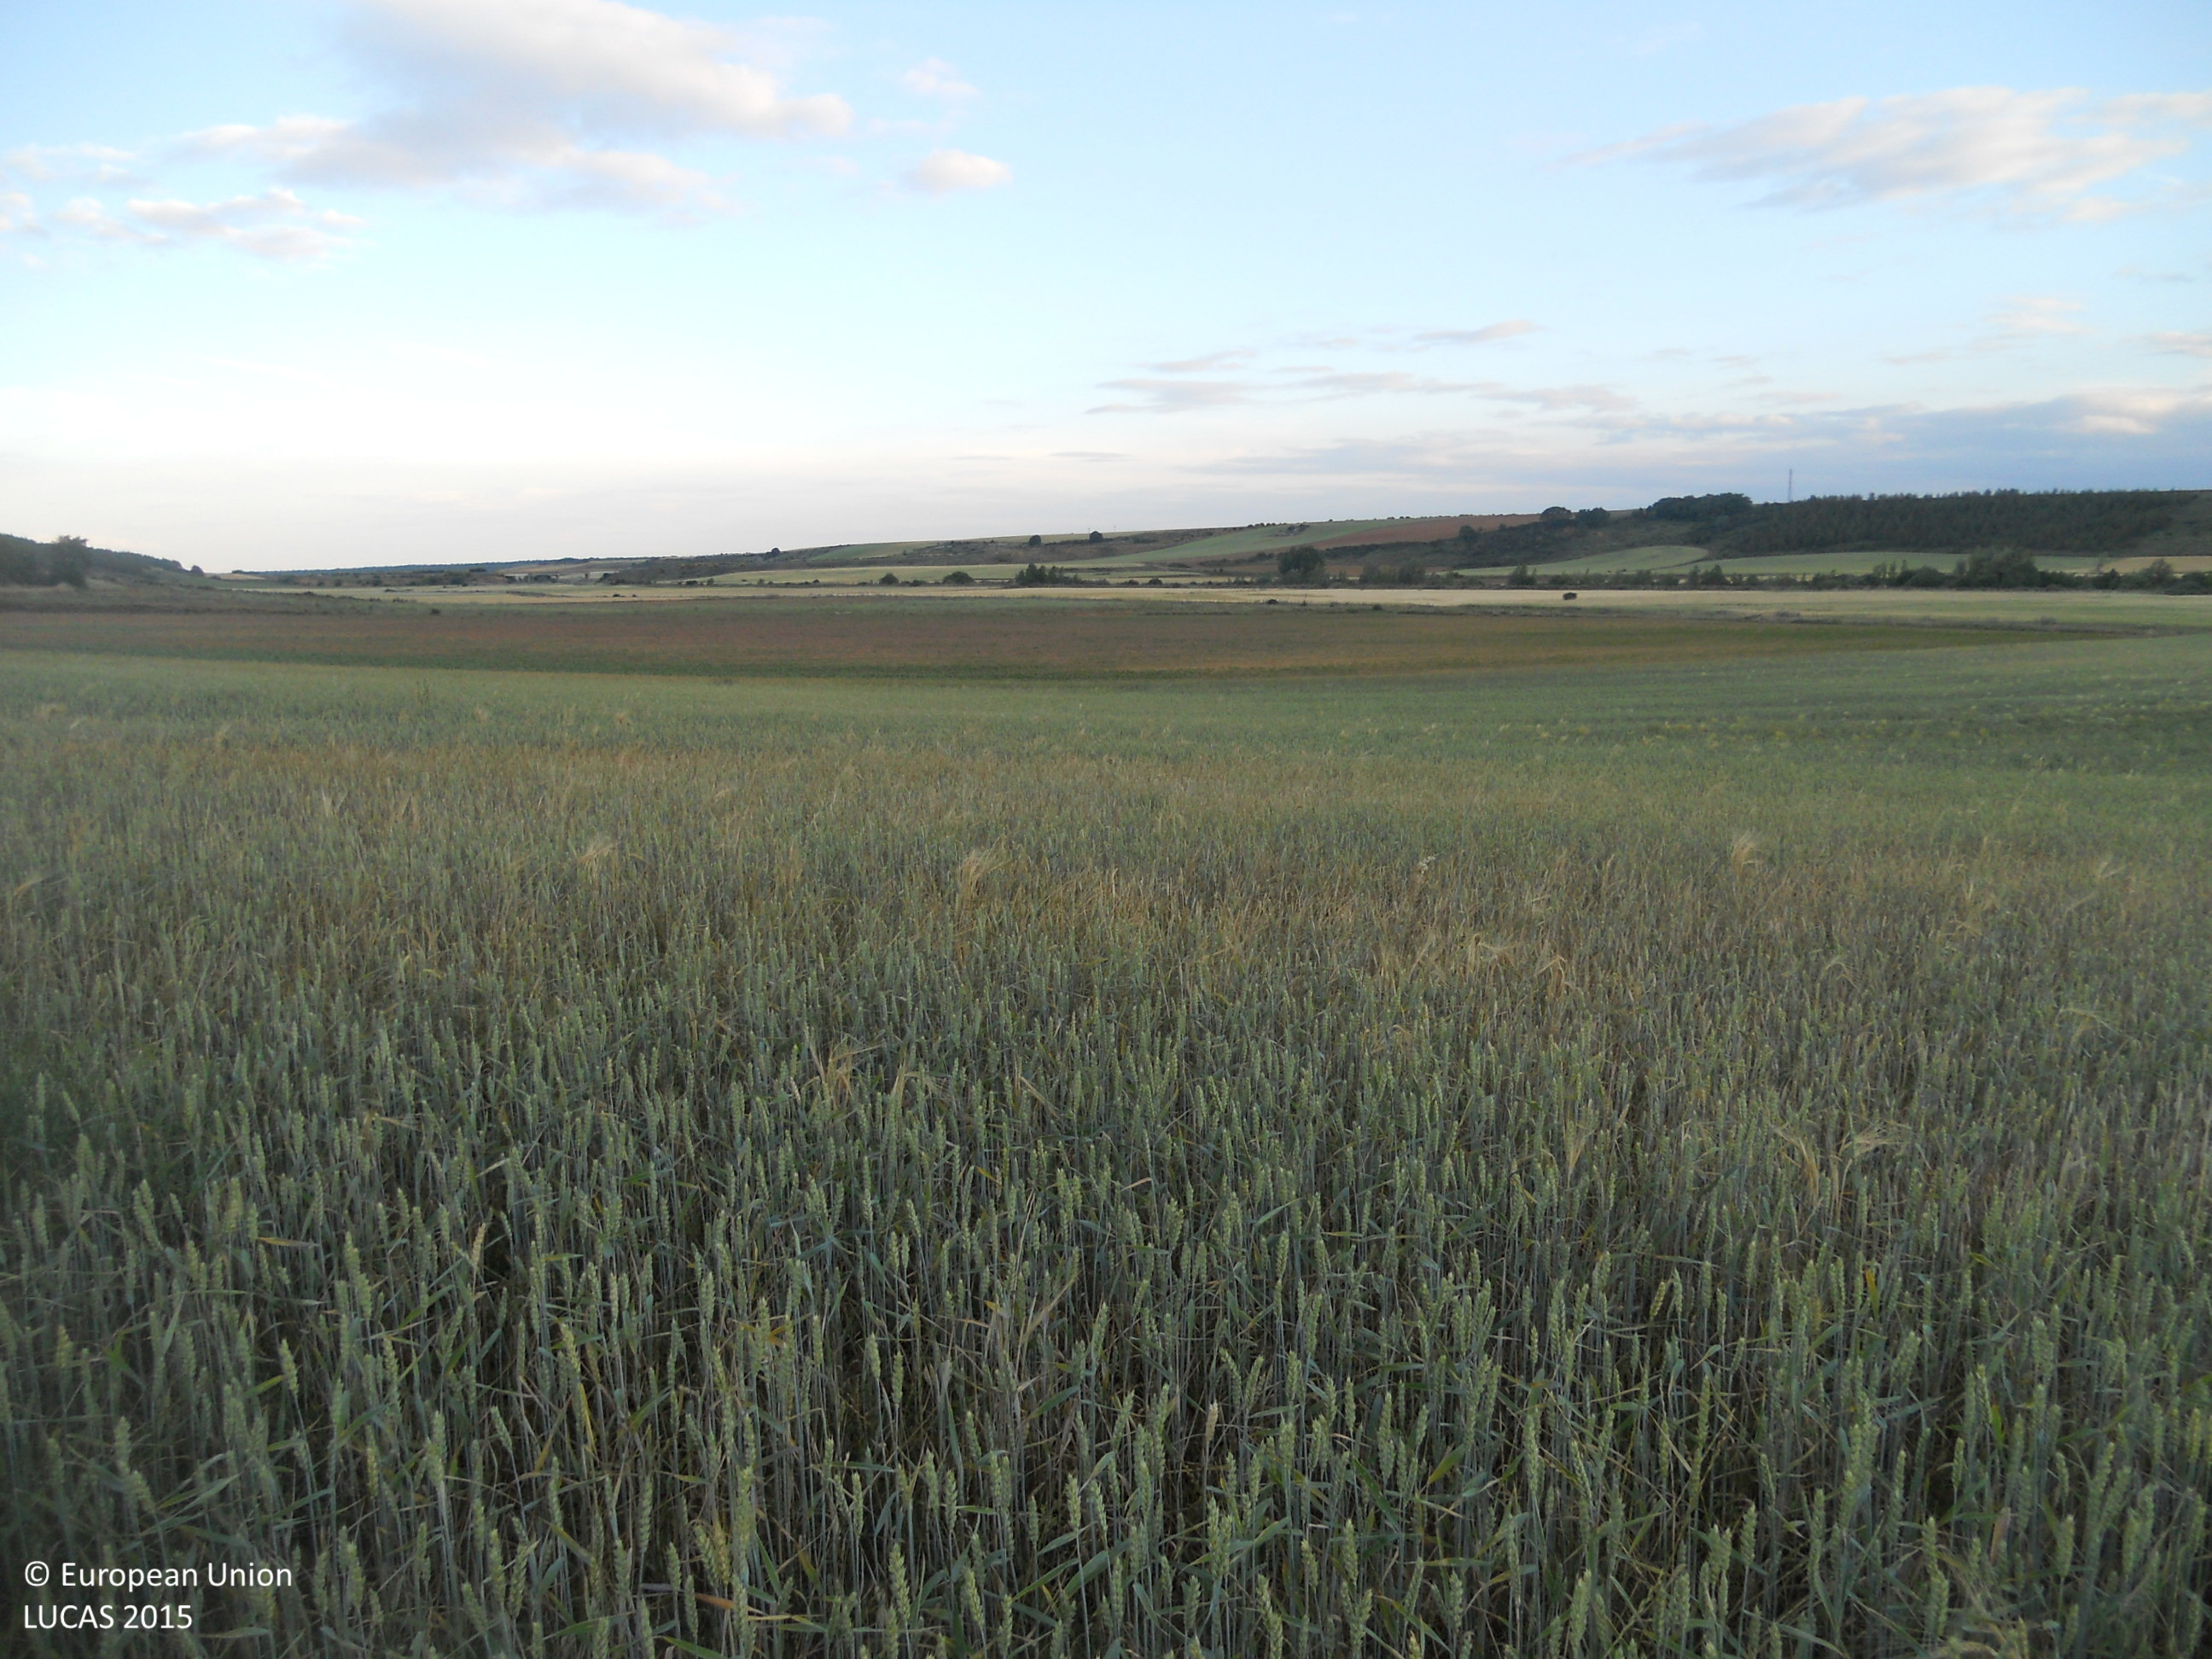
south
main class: Cropland
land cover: Common wheat
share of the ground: > 75 %
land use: Agriculture (excluding fallow land and kitchen gardens)
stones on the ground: < 10 %
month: June
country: ES
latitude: 42.3757
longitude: -4.8603
